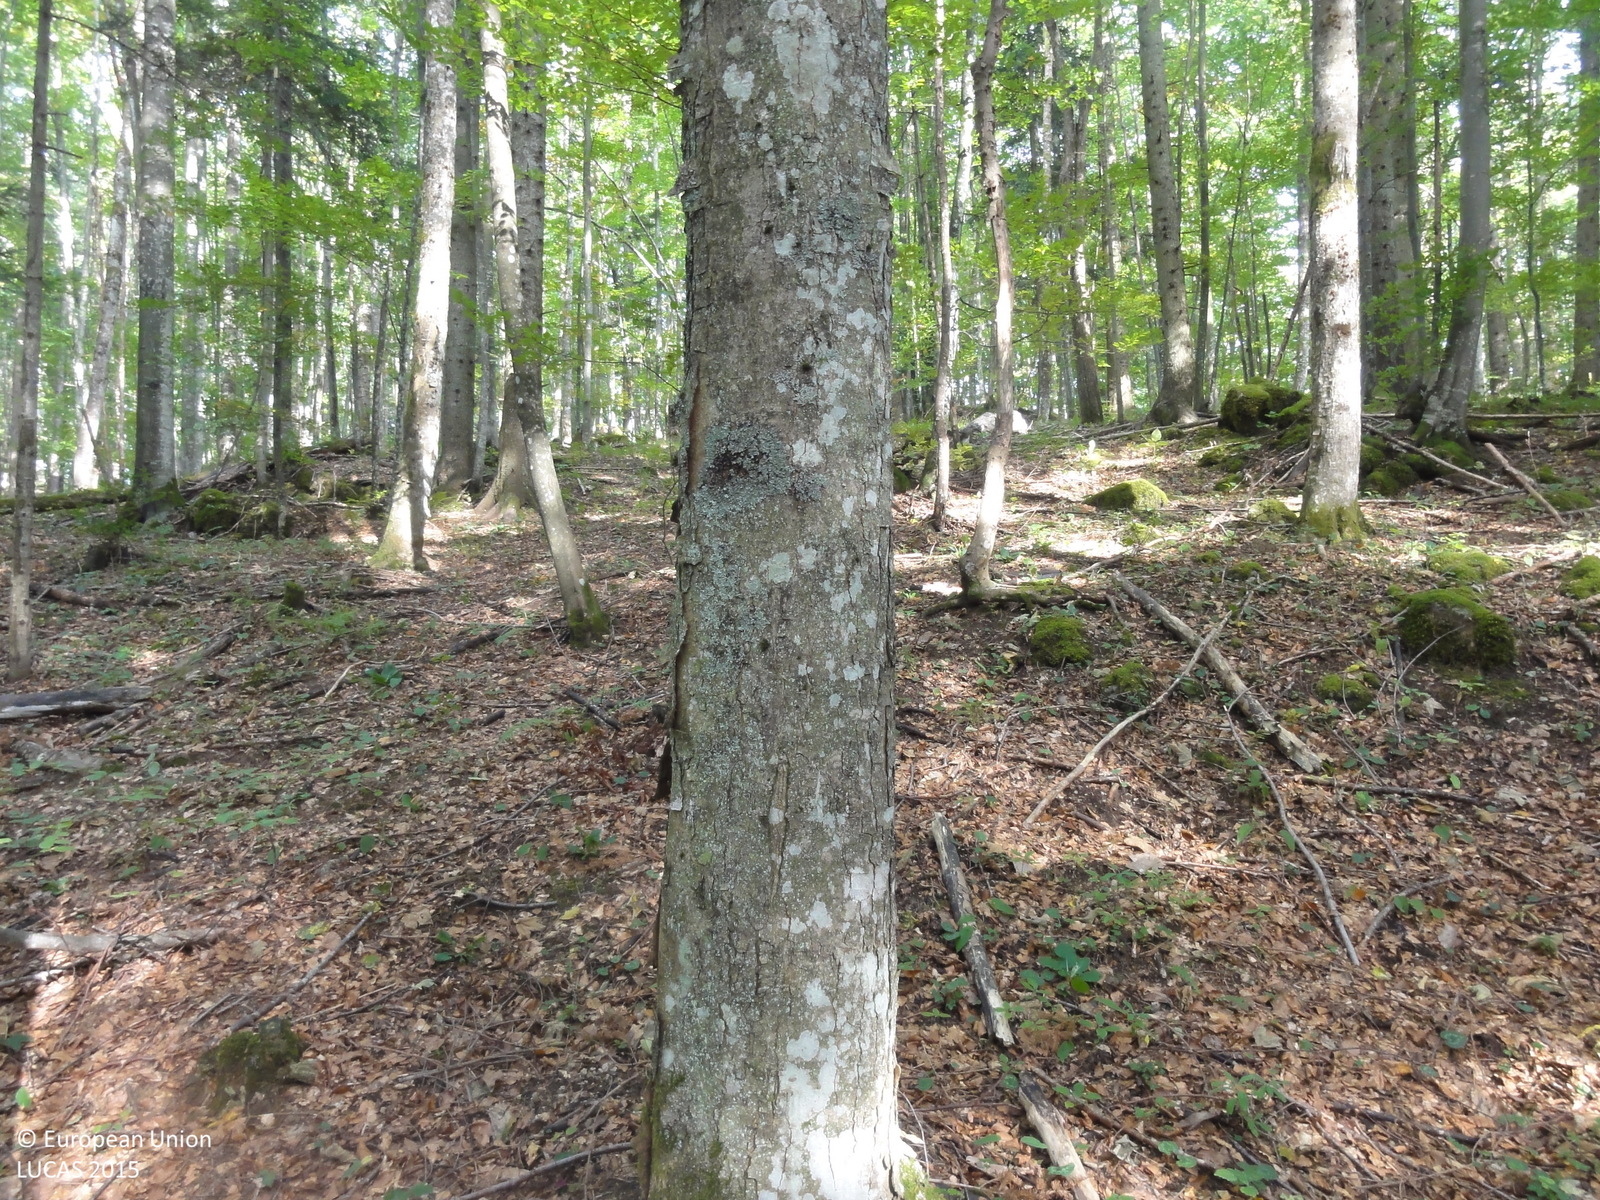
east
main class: Woodland
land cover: Spruce dominated mixed woodland
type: mountainous beech forest
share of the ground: > 75 %
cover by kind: broadleaved forest trees 60 %, coniferous forest trees 40 %
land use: Forestry
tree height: > 5 m
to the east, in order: Spruce dominated mixed woodland; Tracks; Spruce dominated mixed woodland; Tracks; Spruce dominated mixed woodland
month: September
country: SI
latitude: 45.6165
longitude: 15.0872
